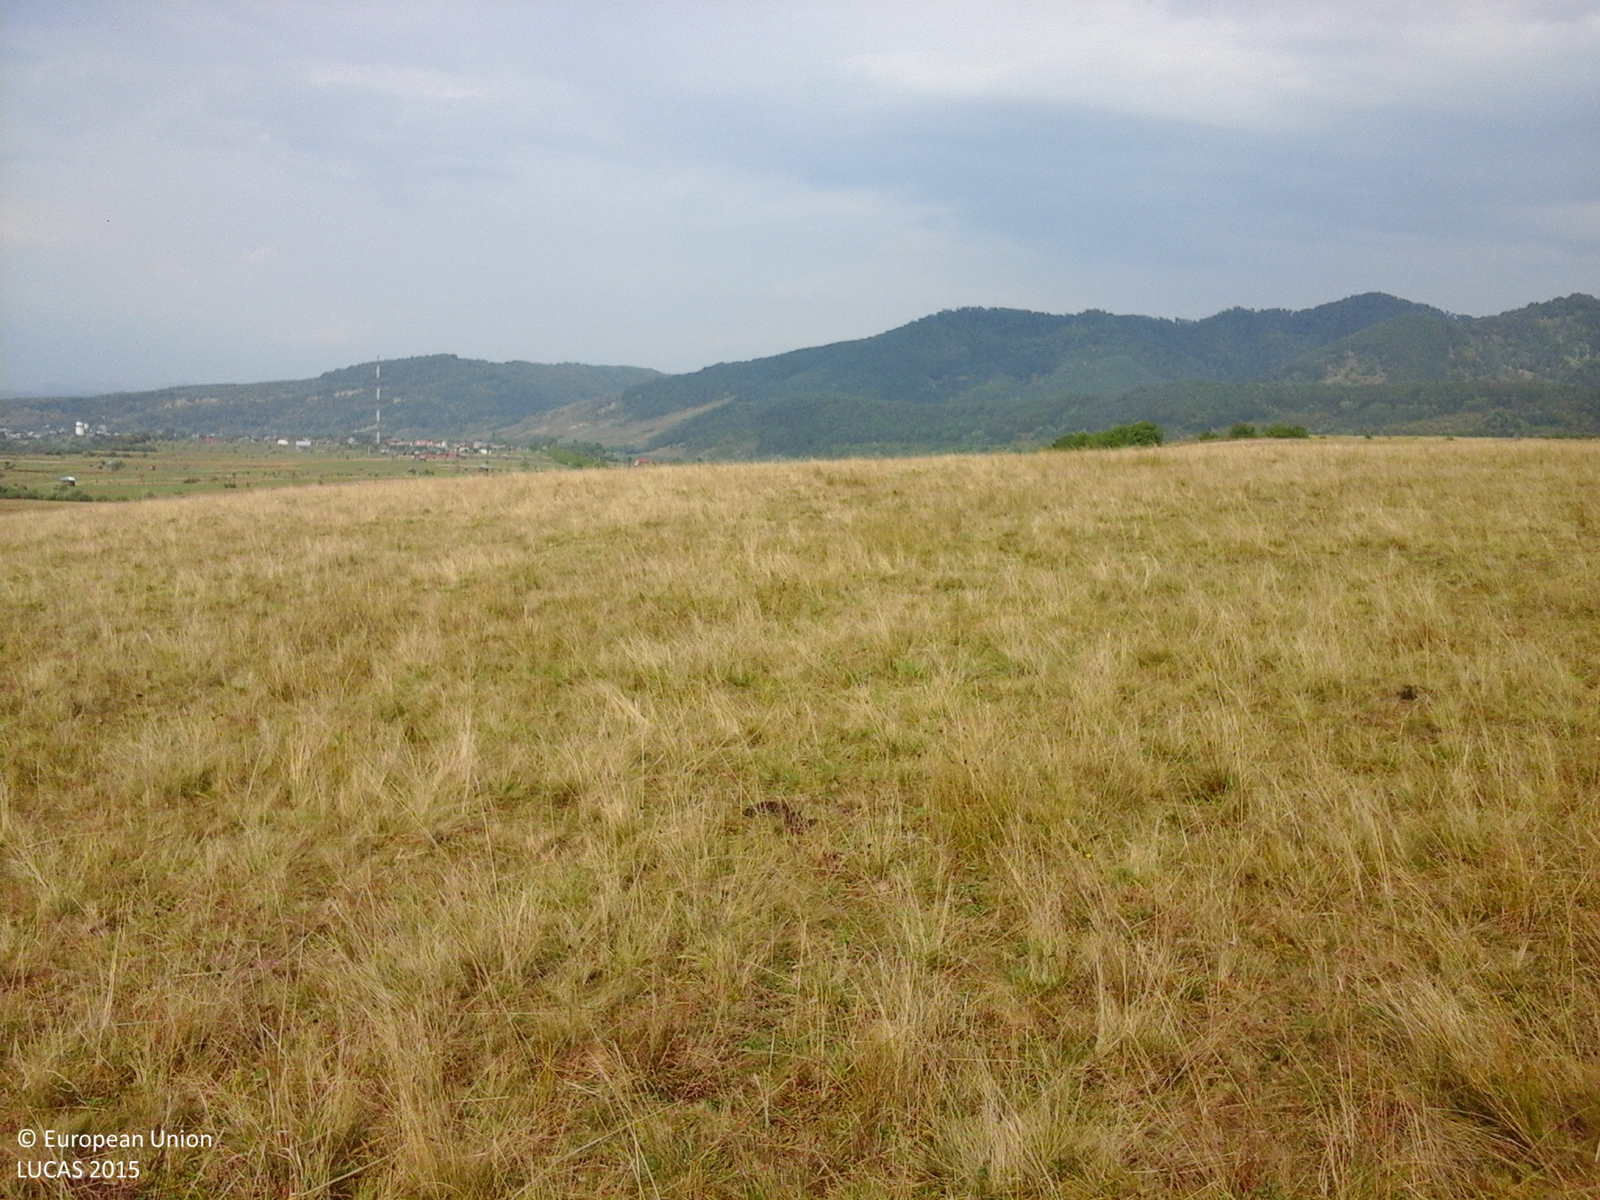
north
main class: Grassland
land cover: Grassland without tree/shrub cover
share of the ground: > 75 %
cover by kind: herbaceous plants 100 %
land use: Agriculture (excluding fallow land and kitchen gardens)
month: September
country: RO
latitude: 47.8612
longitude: 23.9458
